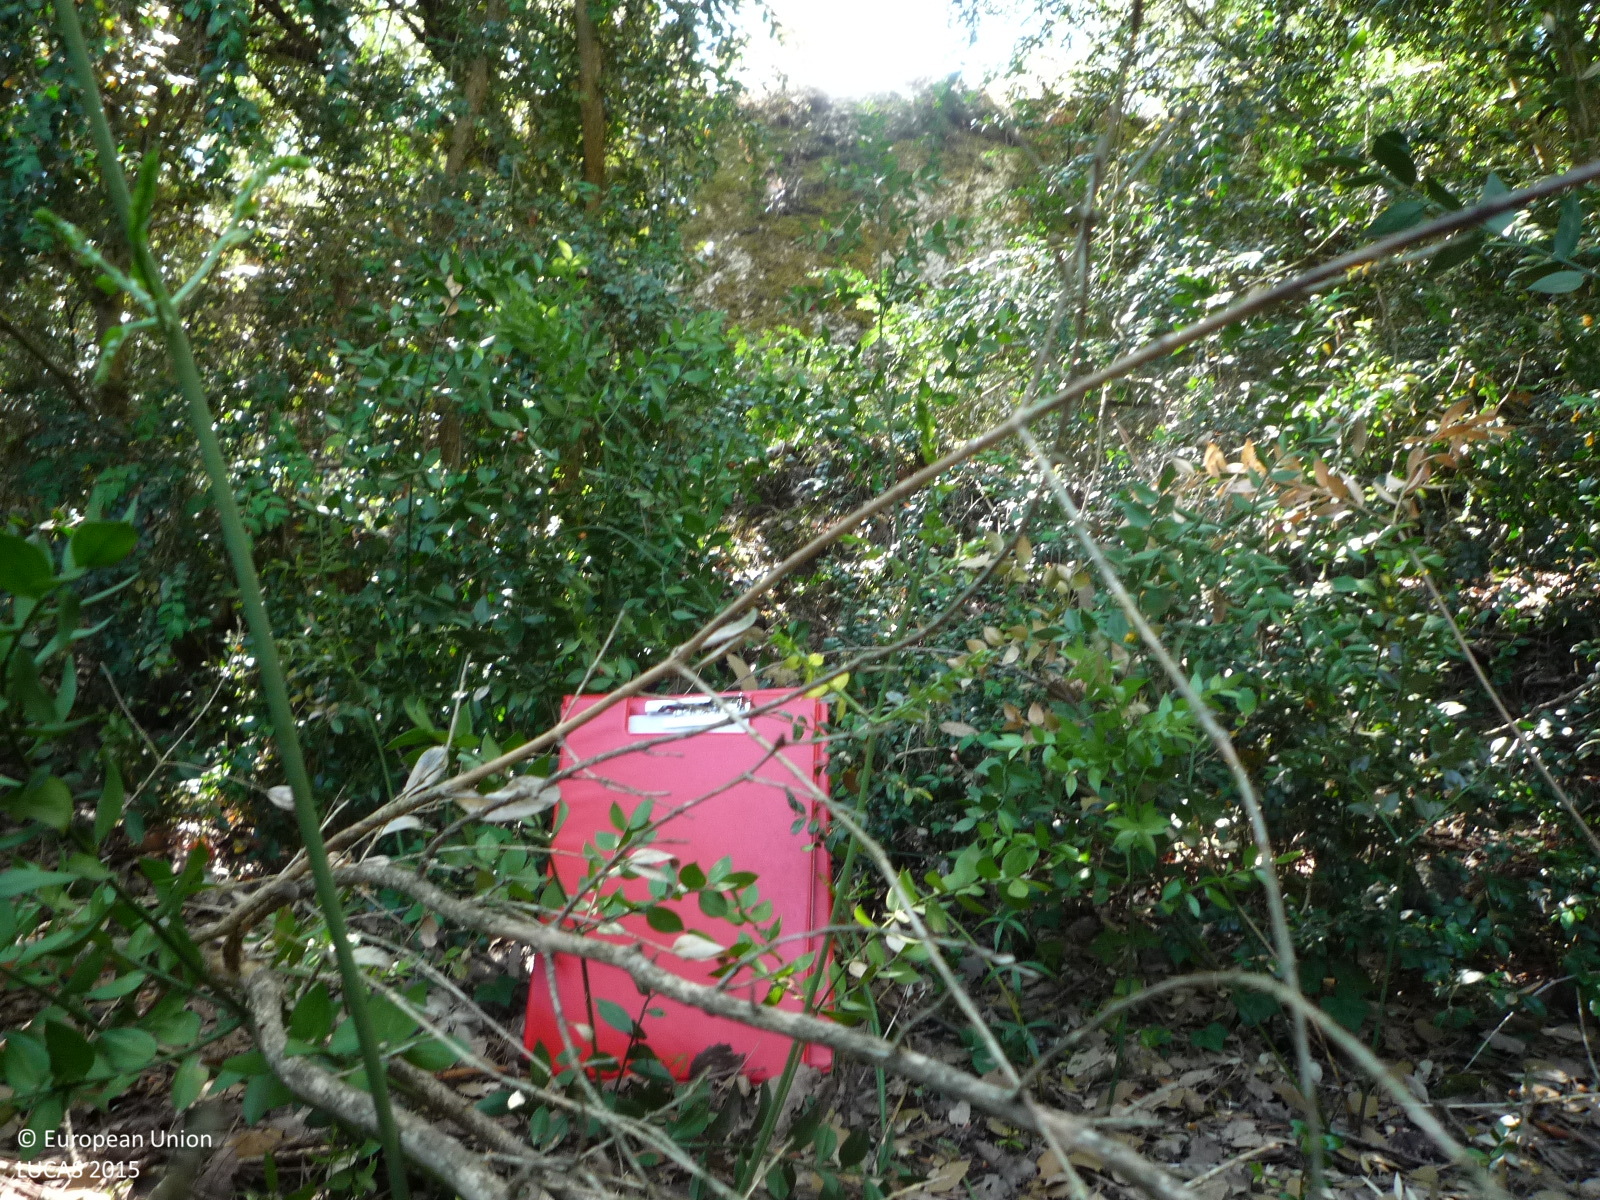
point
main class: Woodland
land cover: Other mixed woodland
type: broadleaved evergreen forest
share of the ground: > 75 %
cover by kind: broadleaved forest trees 50 %, coniferous forest trees 25 %, shrubs 25 %
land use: Semi-natural and natural areas not in use
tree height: > 5 m
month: June
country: ES
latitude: 41.7362
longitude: 1.9719
